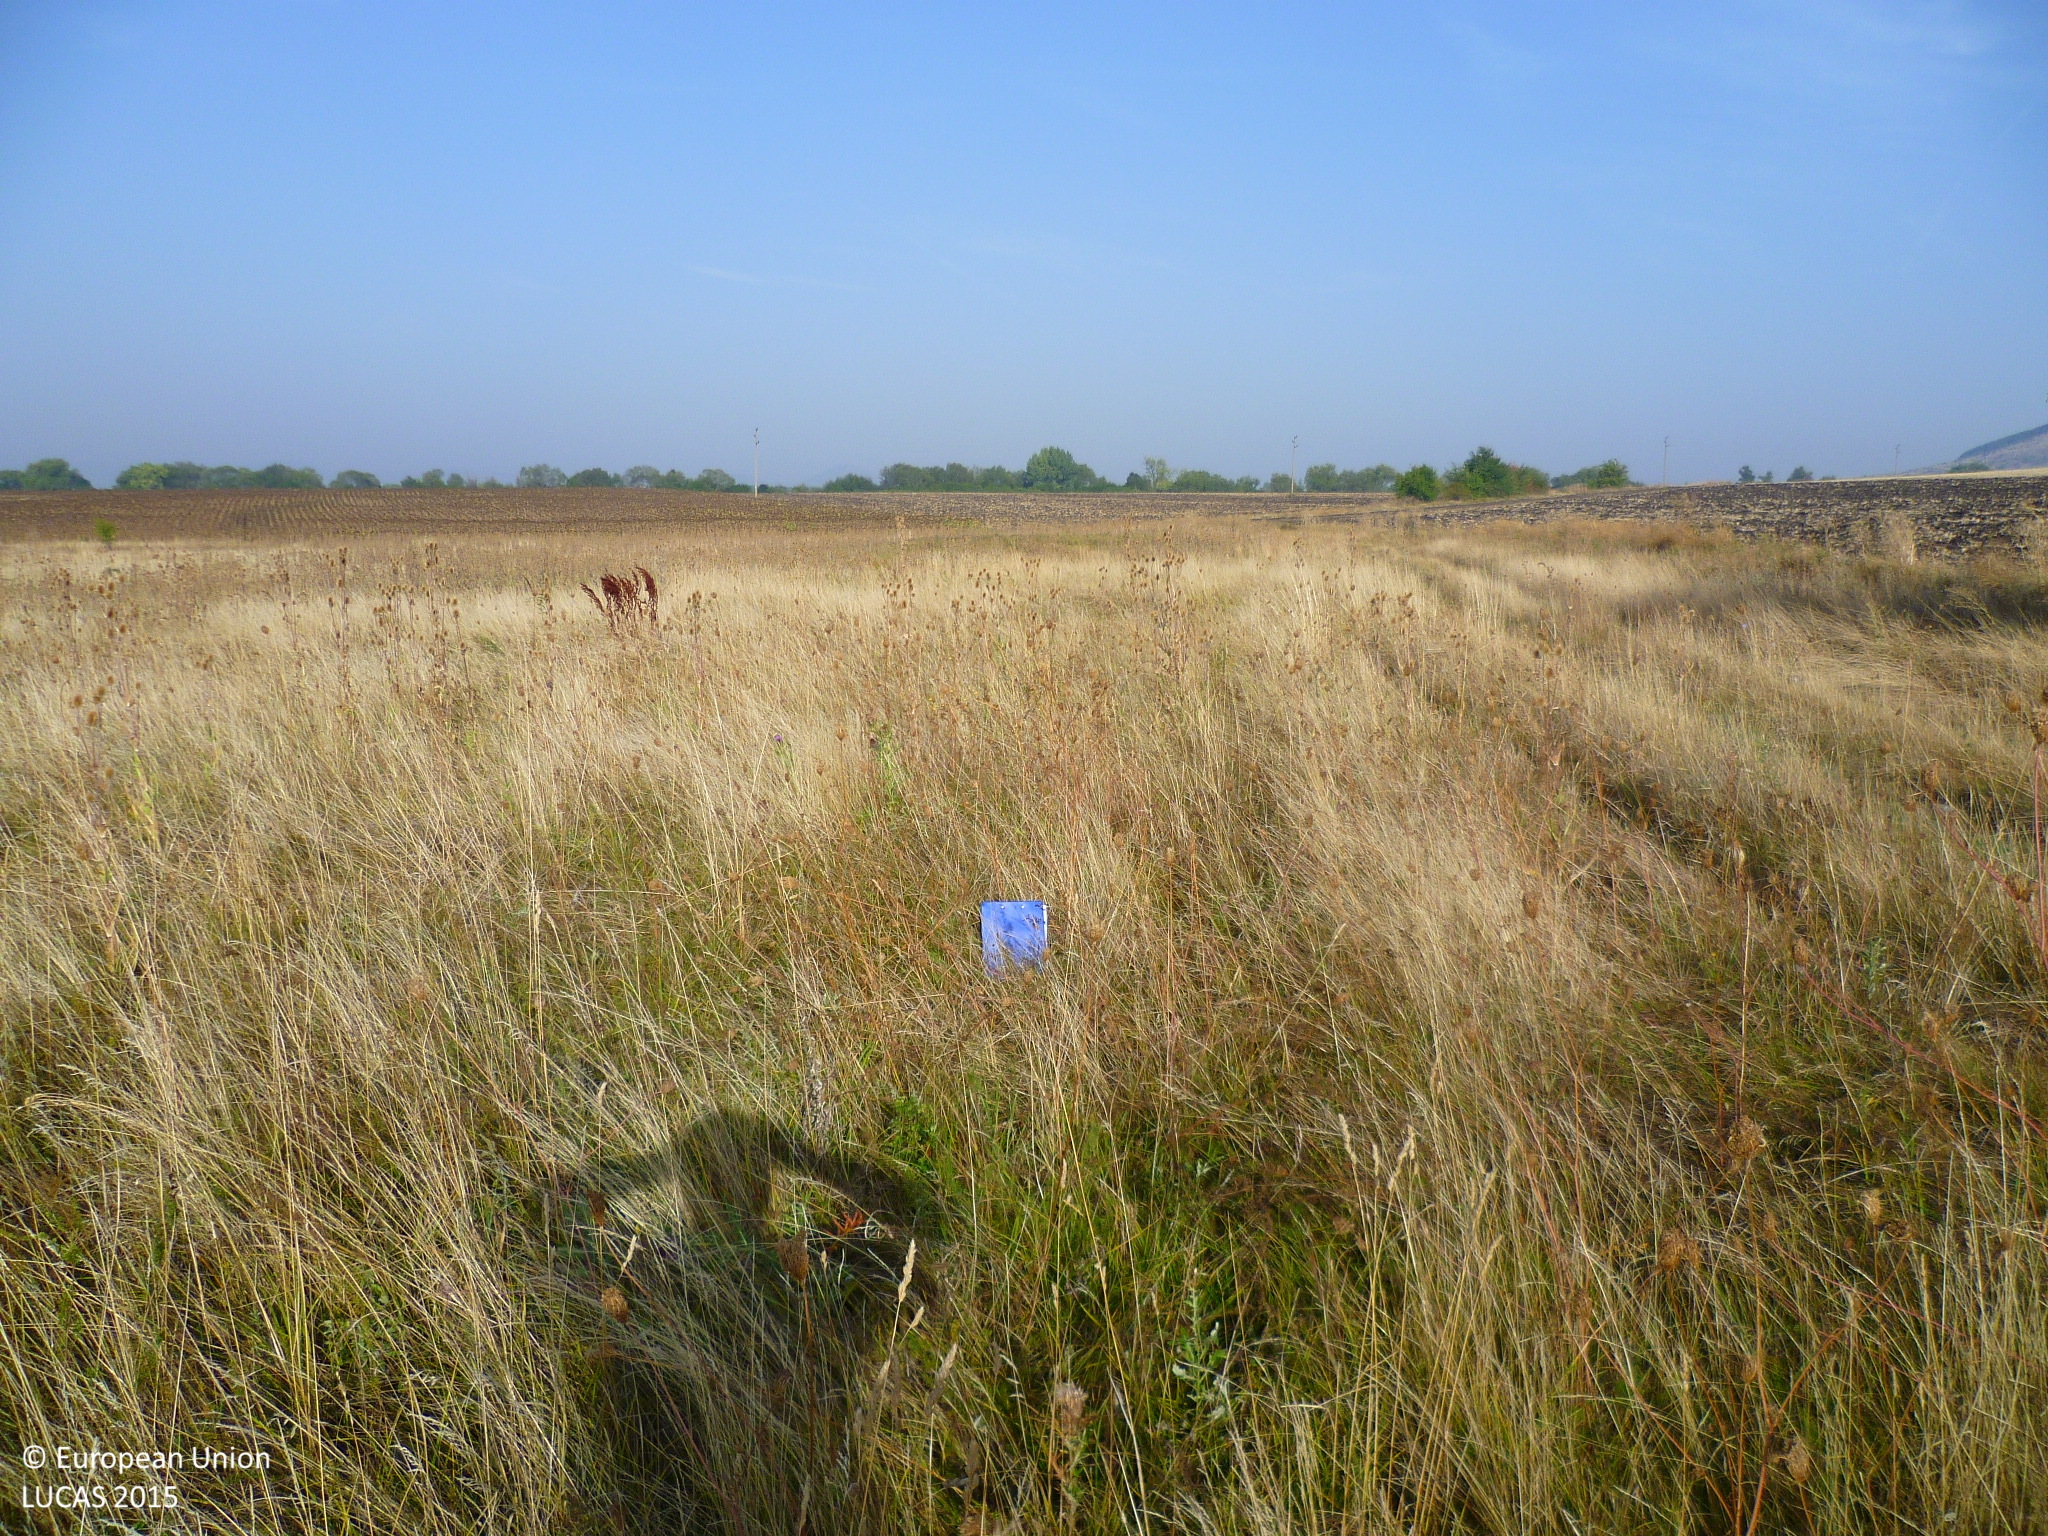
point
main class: Grassland
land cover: Grassland without tree/shrub cover
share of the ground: > 75 %
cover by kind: herbaceous plants 100 %
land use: Agriculture (excluding fallow land and kitchen gardens)
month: September
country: BG
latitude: 42.6885
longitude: 23.0039
